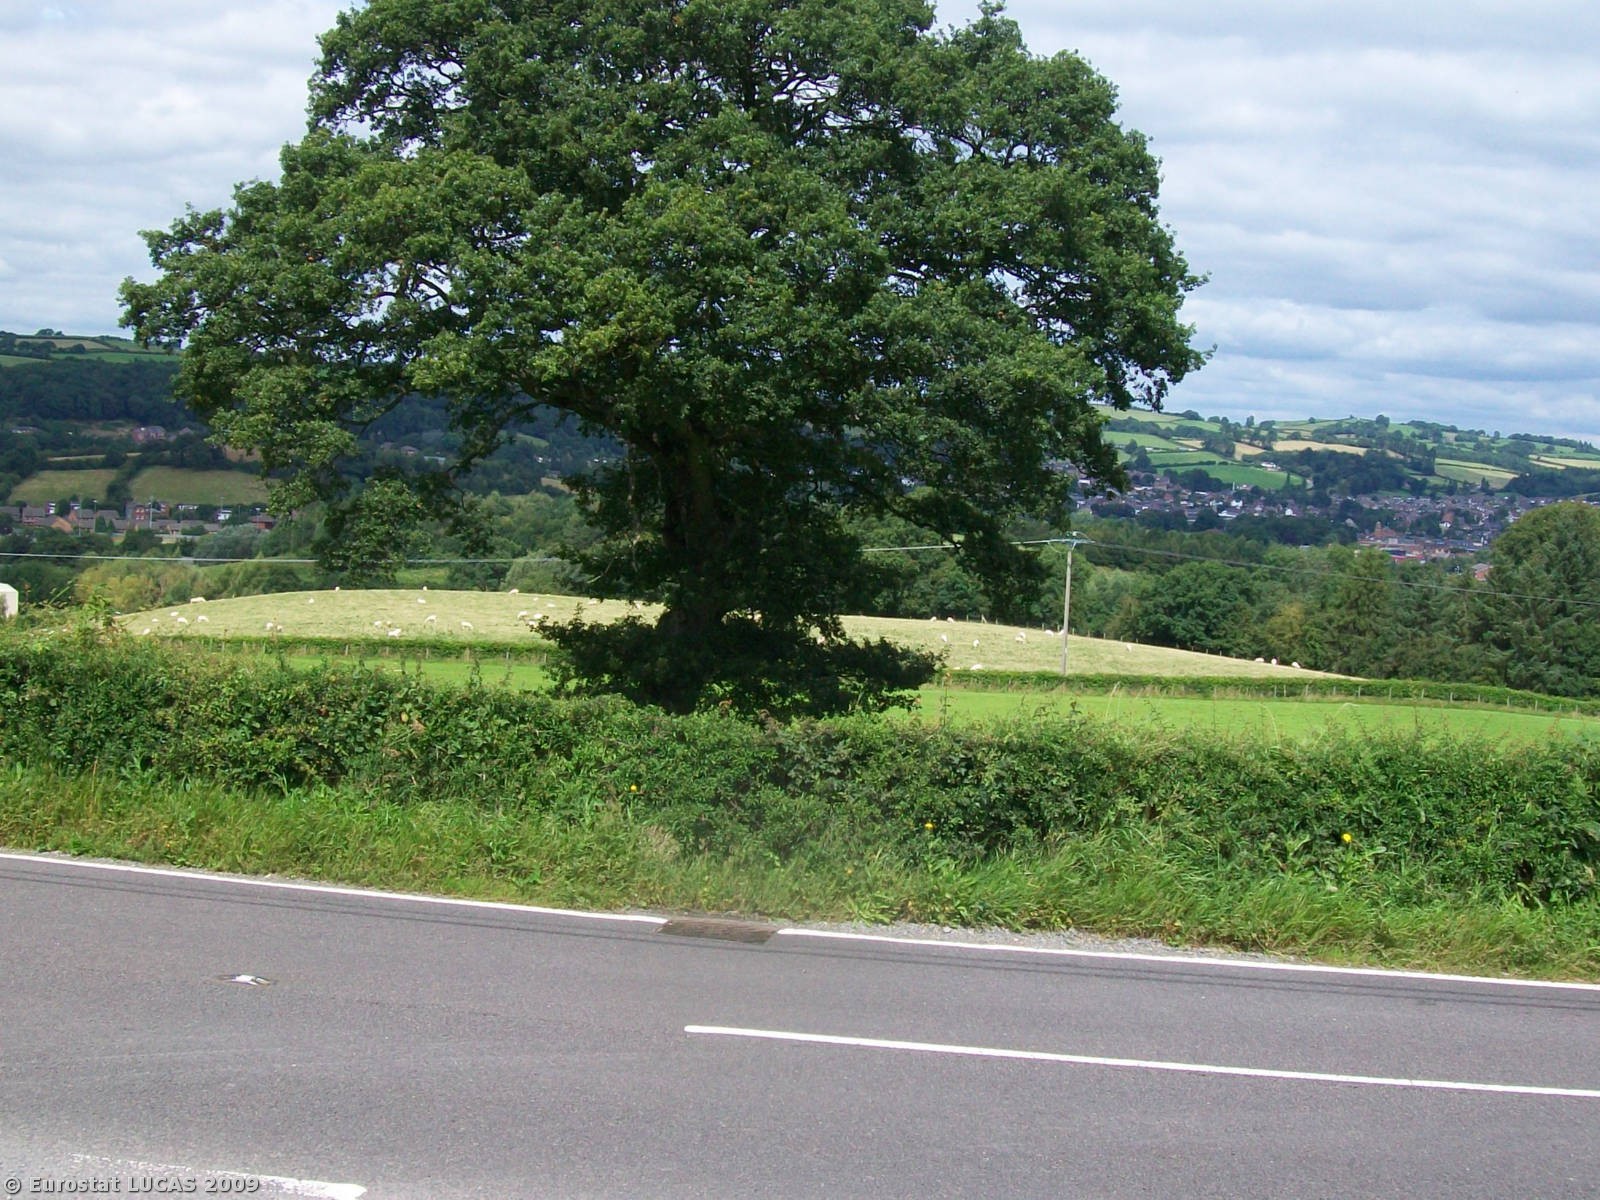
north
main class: Grassland
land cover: Grassland without tree/shrub cover
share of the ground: > 75 %
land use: Agriculture (excluding fallow land and kitchen gardens)
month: August
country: GB
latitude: 52.4973
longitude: -3.3231
